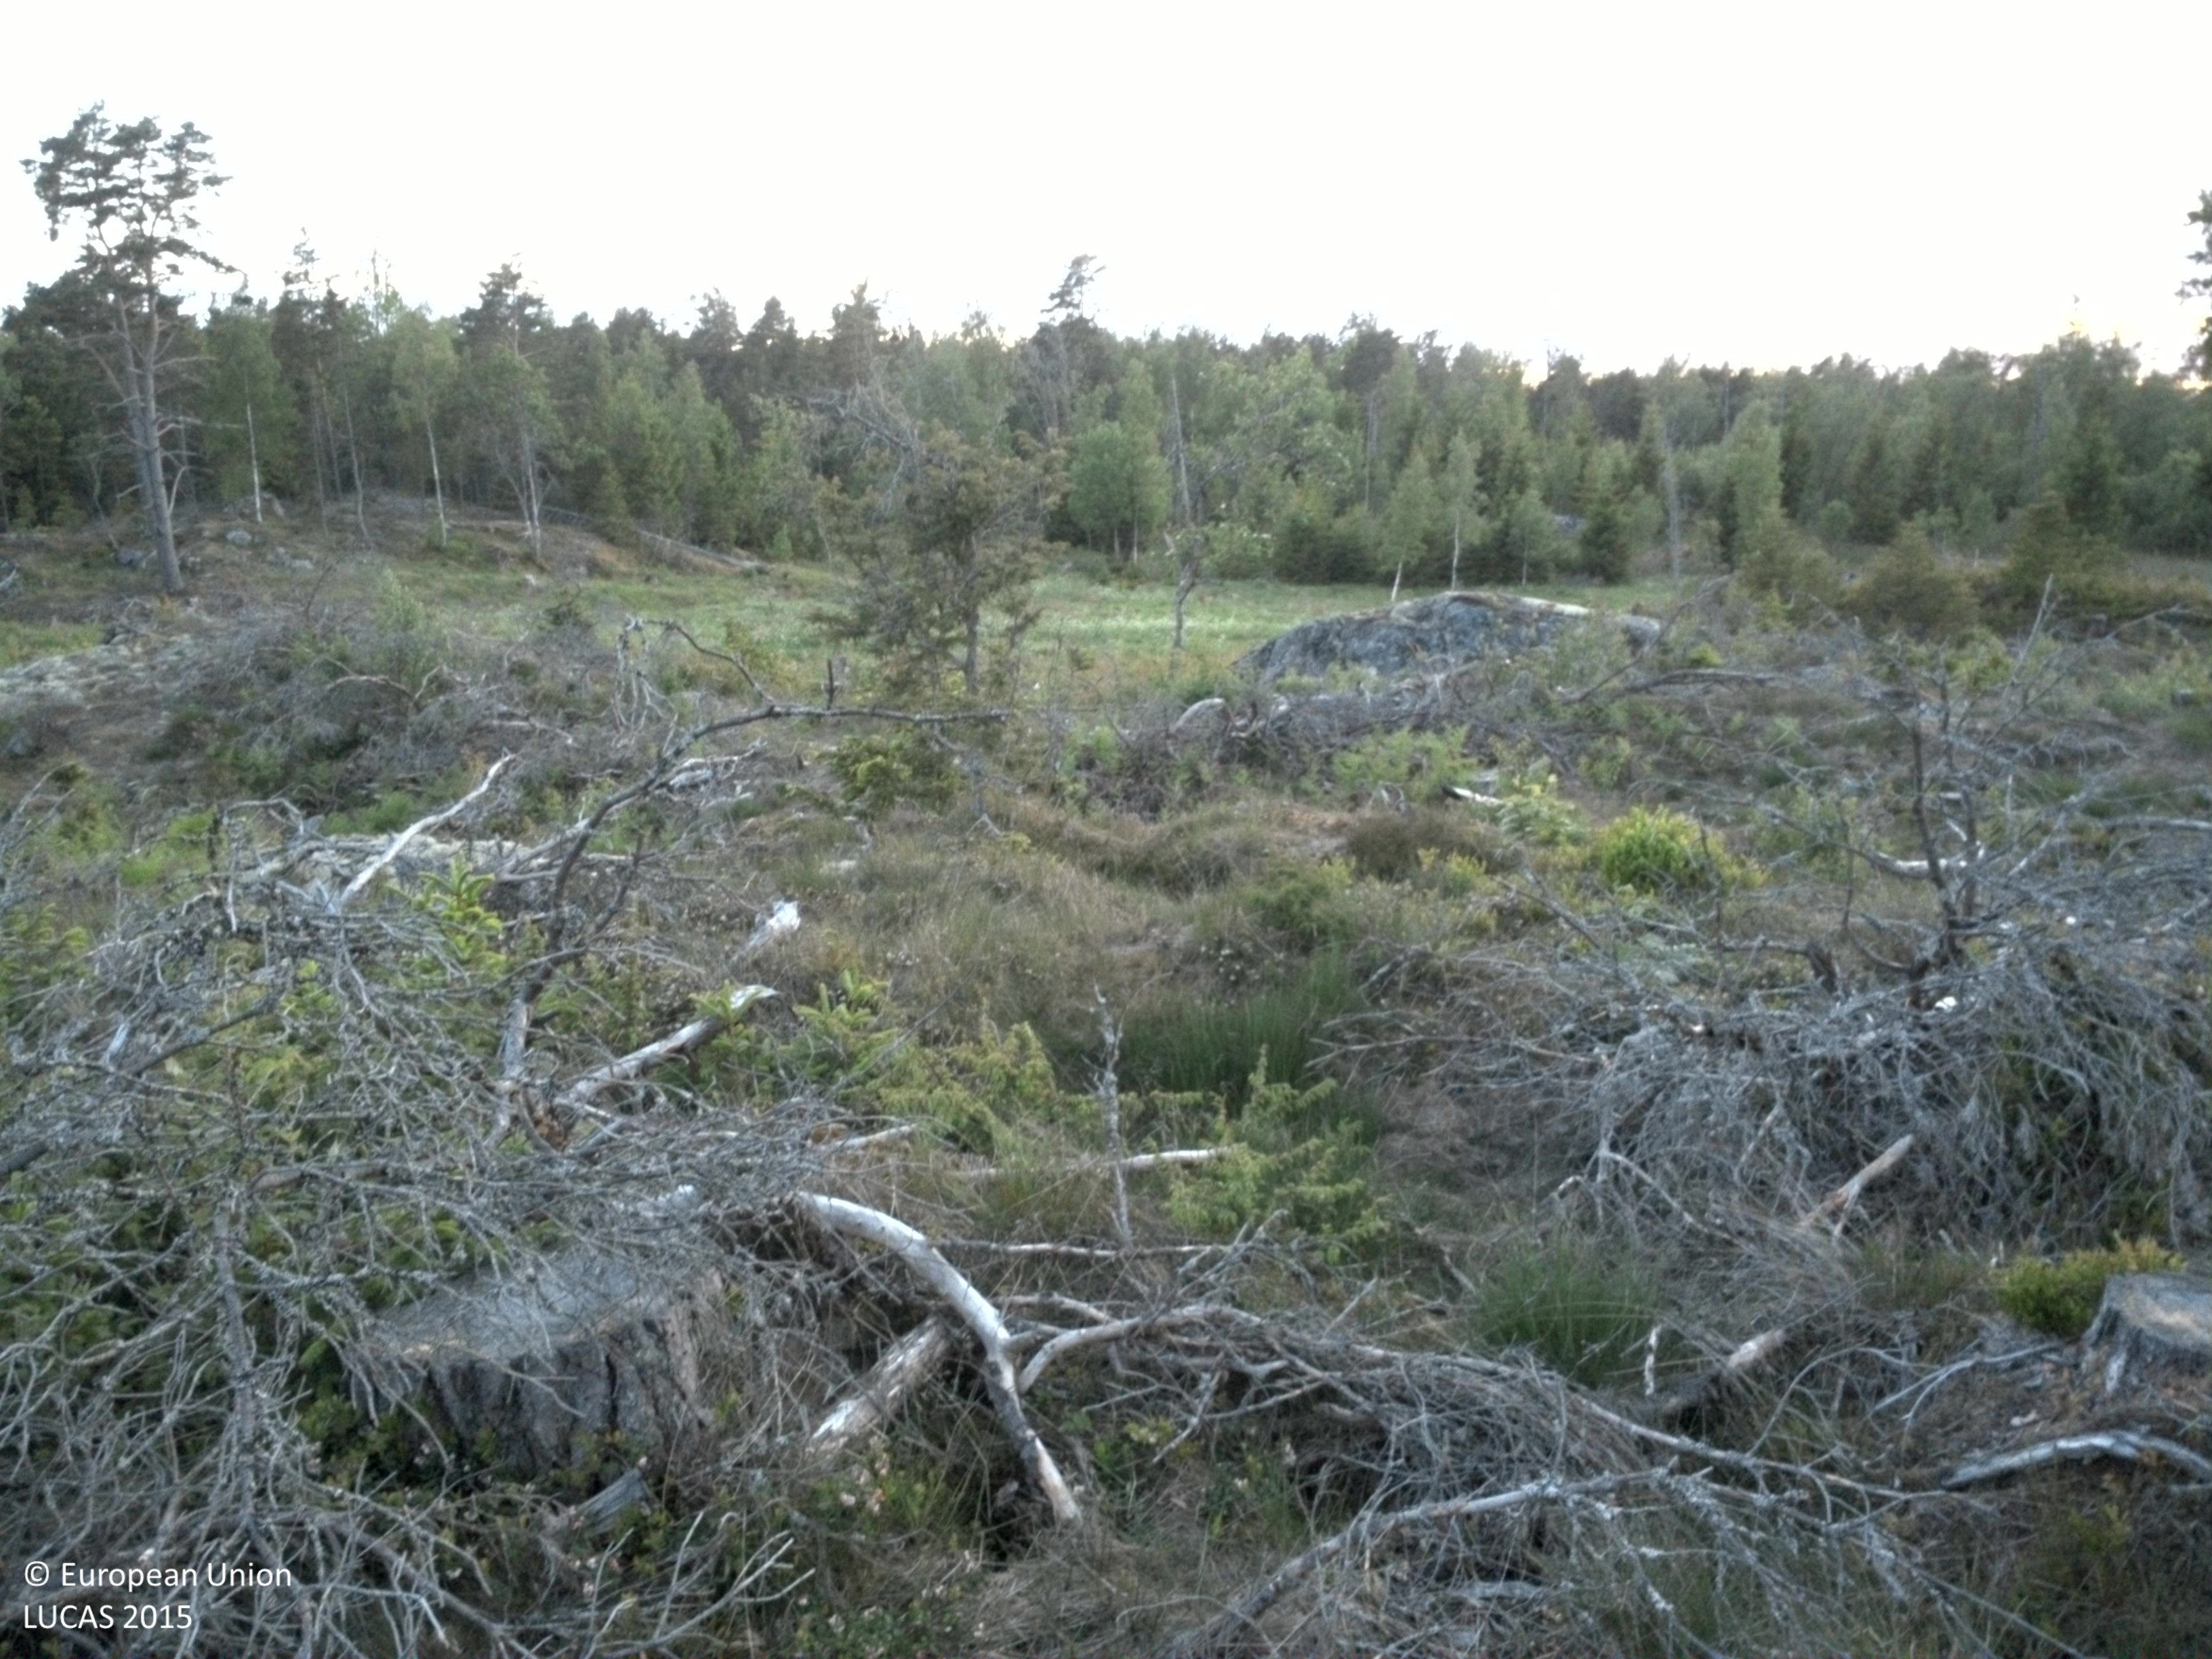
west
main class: Shrubland
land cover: Shrubland with sparse tree cover
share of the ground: 25 - 50 %
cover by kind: shrubs 35 %, consolidated bare surface 30 %, herbaceous plants 20 %, lichens and mosses 10 %, coniferous forest trees 5 %
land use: Forestry
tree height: > 5 m
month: June
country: SE
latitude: 60.0516
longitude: 18.7805
